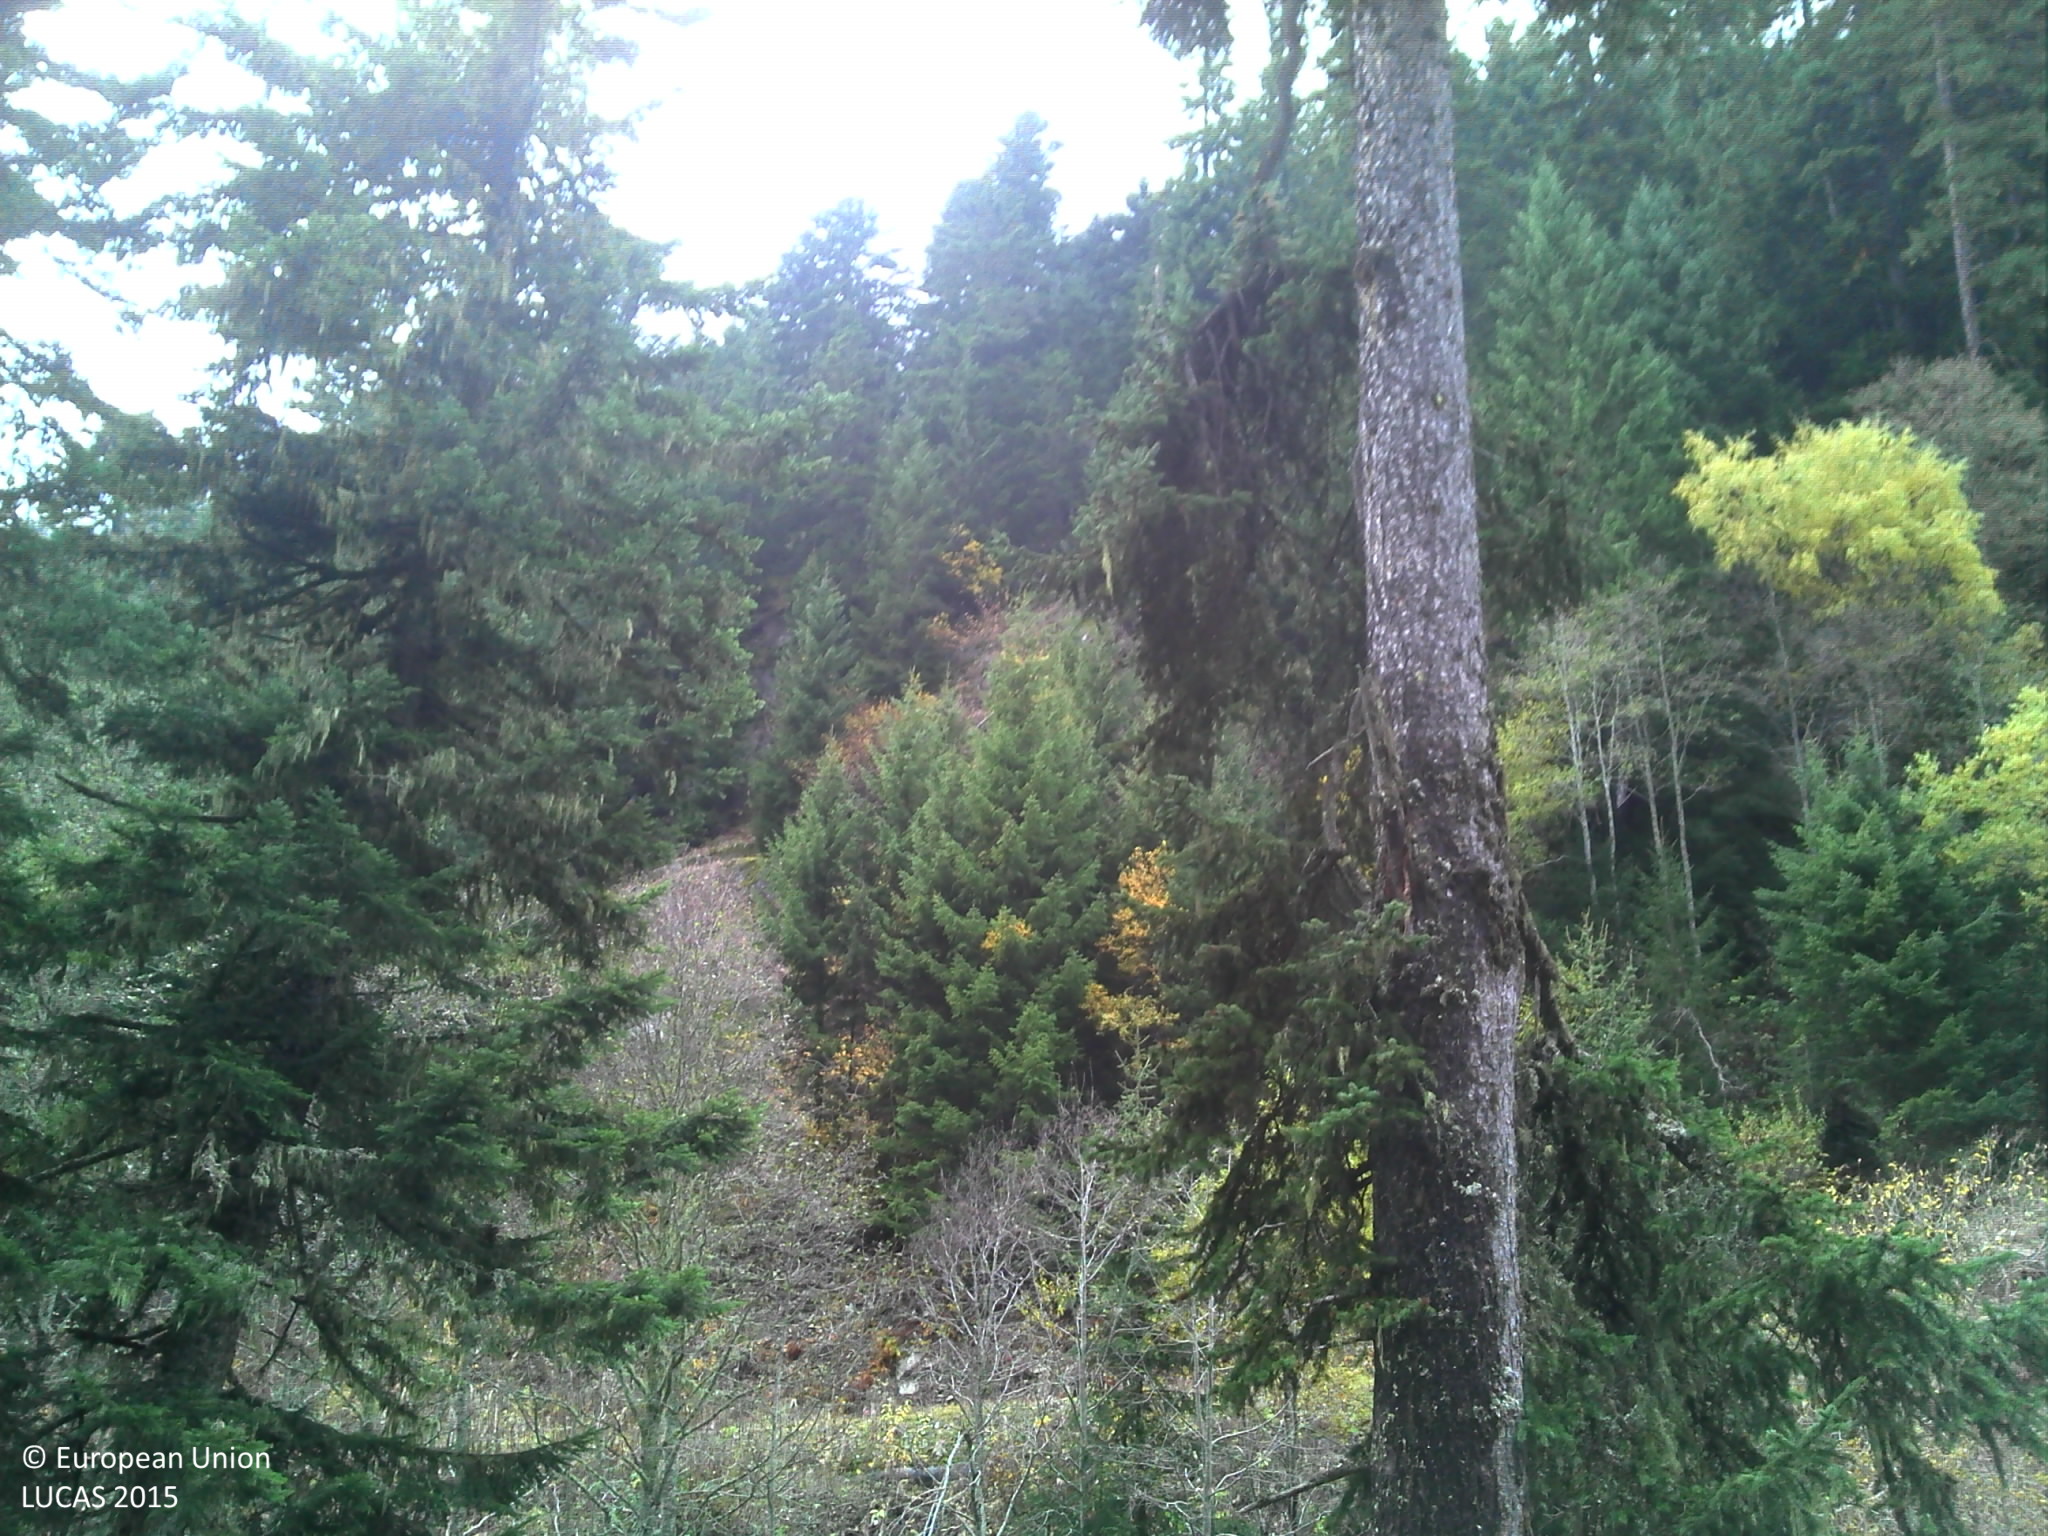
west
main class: Woodland
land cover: Spruce dominated mixed woodland
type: alpine coniferous forest
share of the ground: > 75 %
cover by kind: coniferous forest trees 55 %, broadleaved forest trees 35 %, consolidated bare surface 10 %
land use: Forestry
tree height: > 5 m
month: October
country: FR
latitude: 45.5729
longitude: 6.5062
